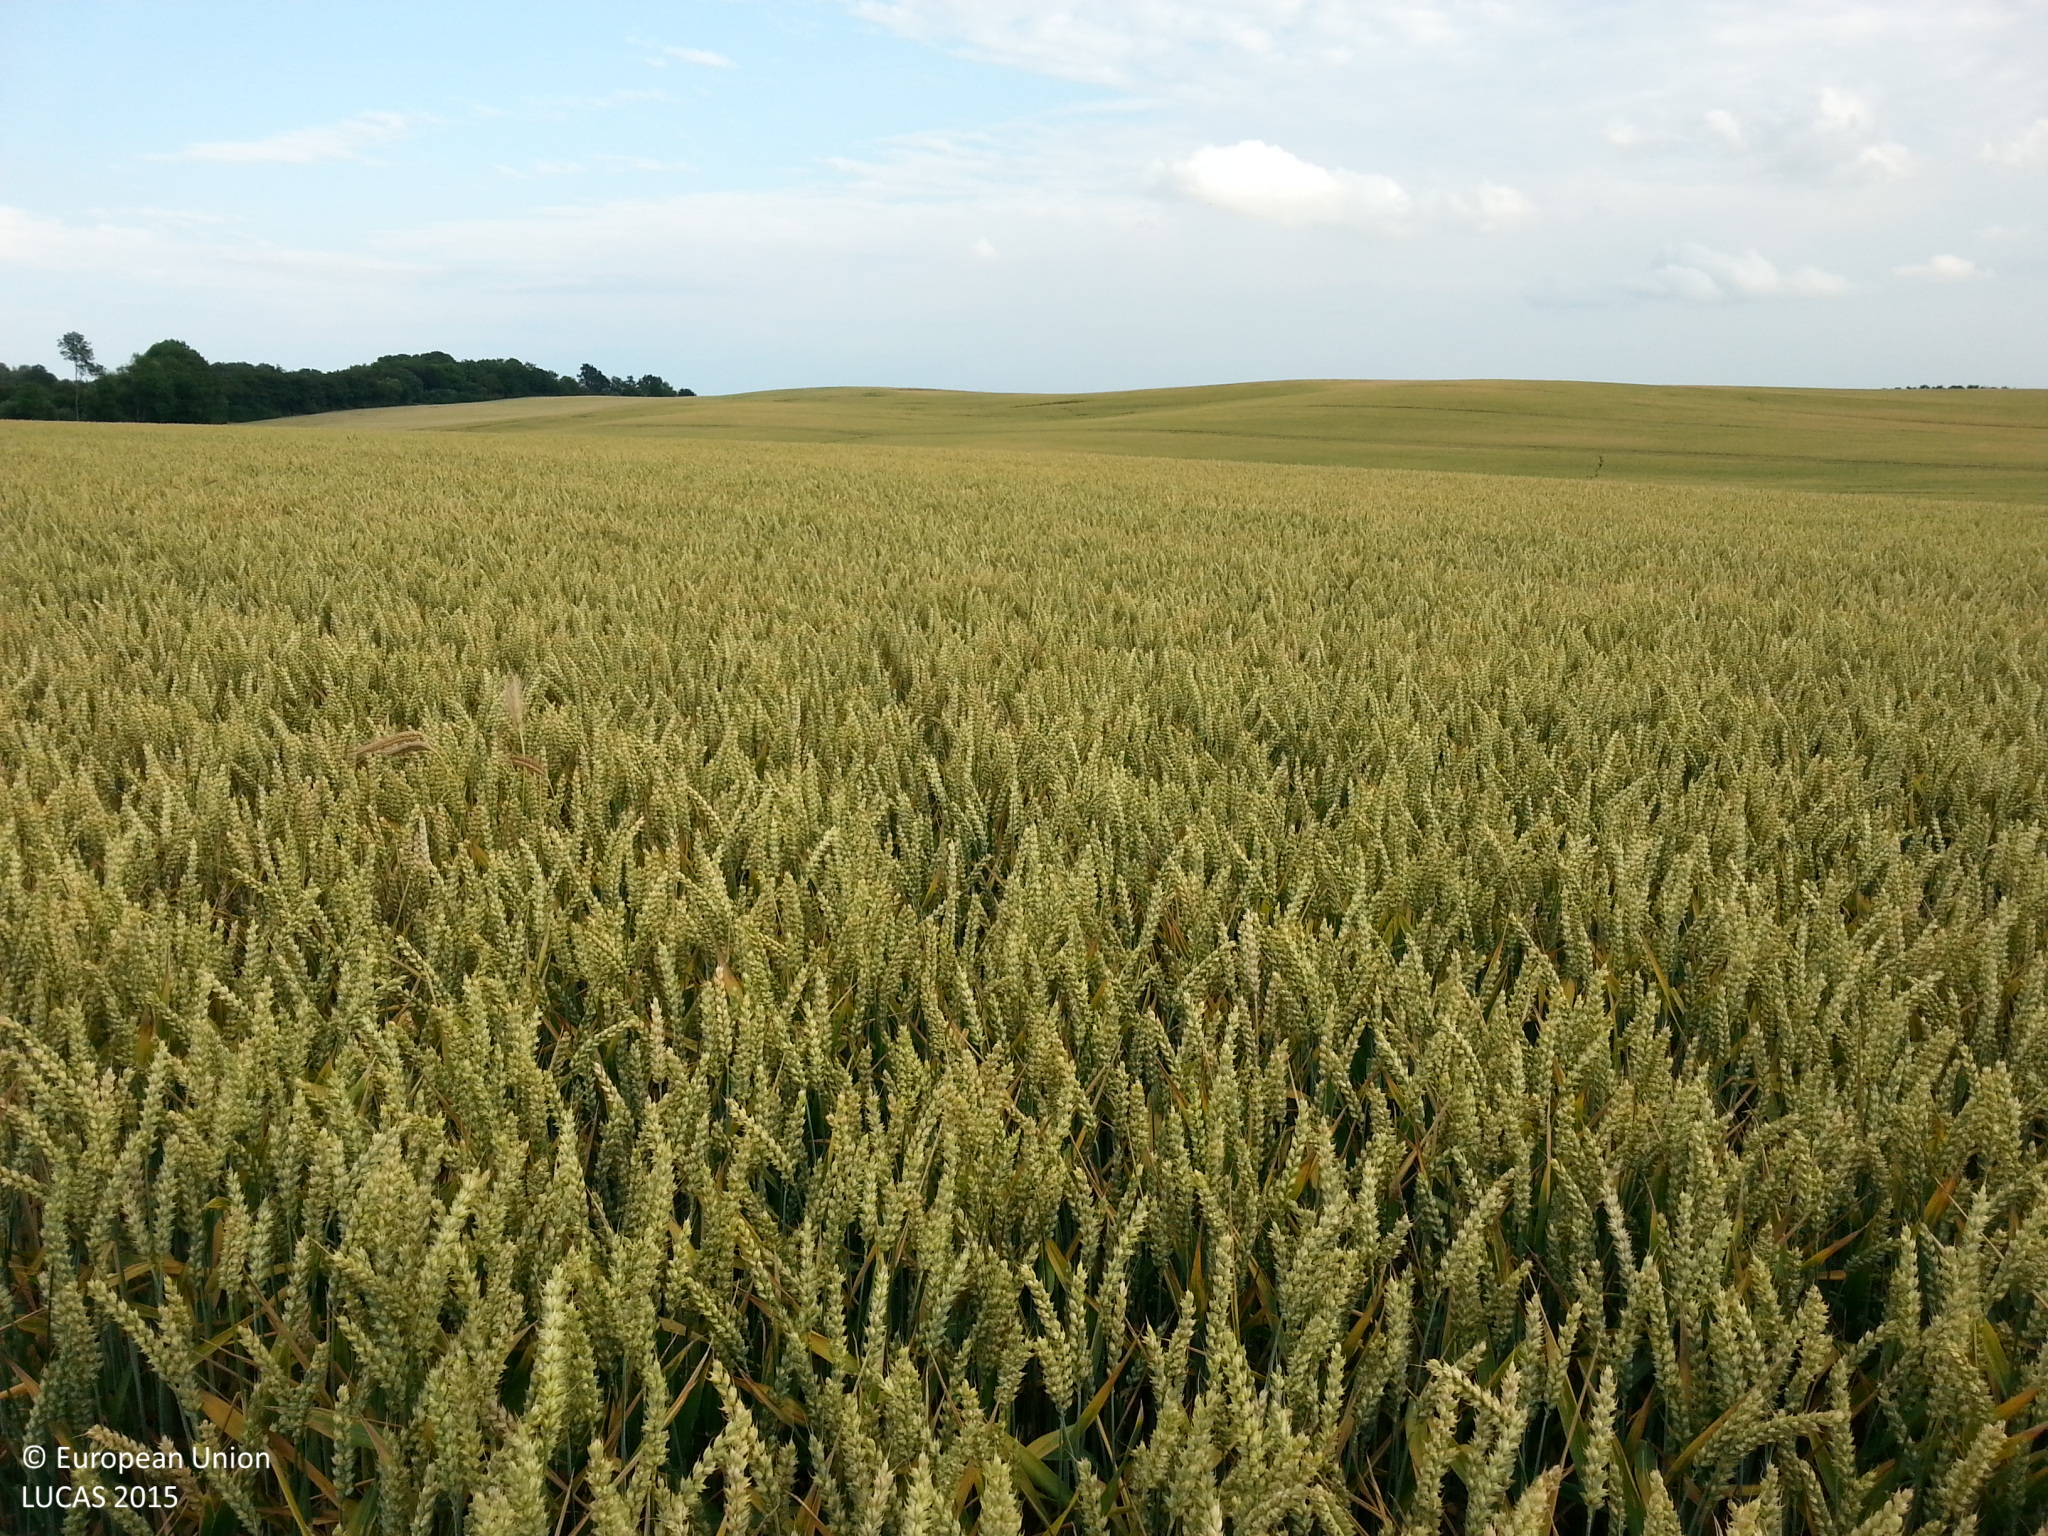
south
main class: Cropland
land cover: Common wheat
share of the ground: > 75 %
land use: Agriculture (excluding fallow land and kitchen gardens)
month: July
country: DE
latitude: 53.9534
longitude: 11.1728
